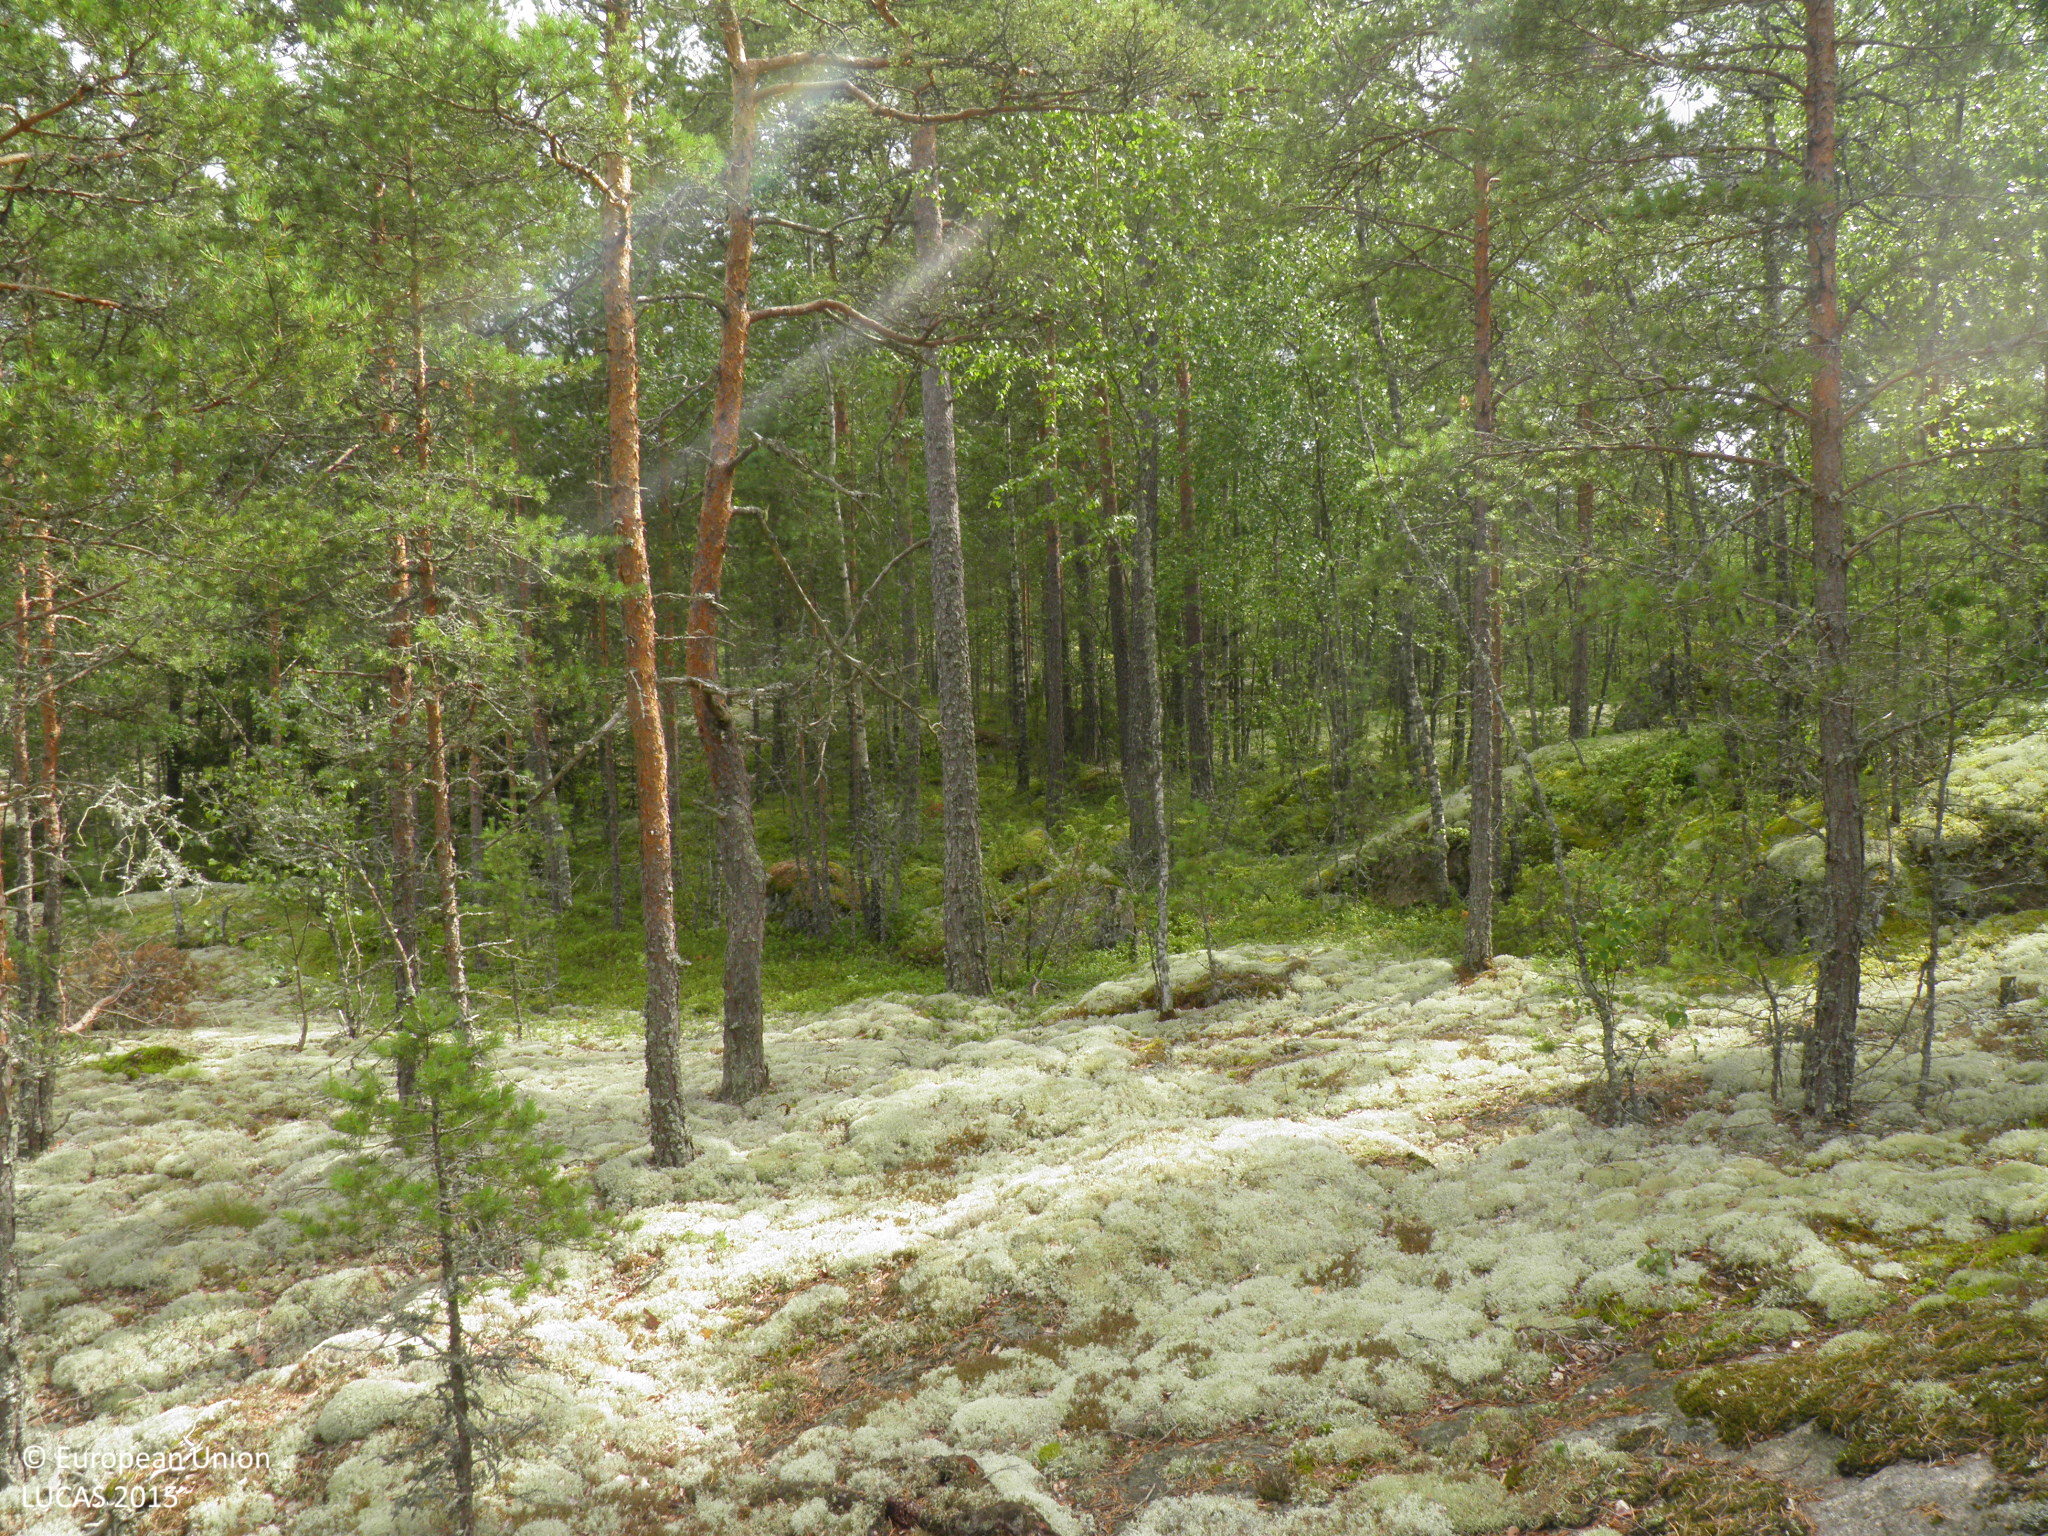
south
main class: Woodland
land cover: Pine dominated coniferous woodland
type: hemiboreal forest and nemoral coniferous forest and mixed broadleaved-coniferous forest
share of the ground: 25 - 50 %
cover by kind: lichens and mosses 50 %, coniferous forest trees 25 %, unconsolidated bare surface 20 %, broadleaved forest trees 5 %
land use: Forestry
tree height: > 5 m
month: July
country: FI
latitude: 60.5509
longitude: 21.6737
